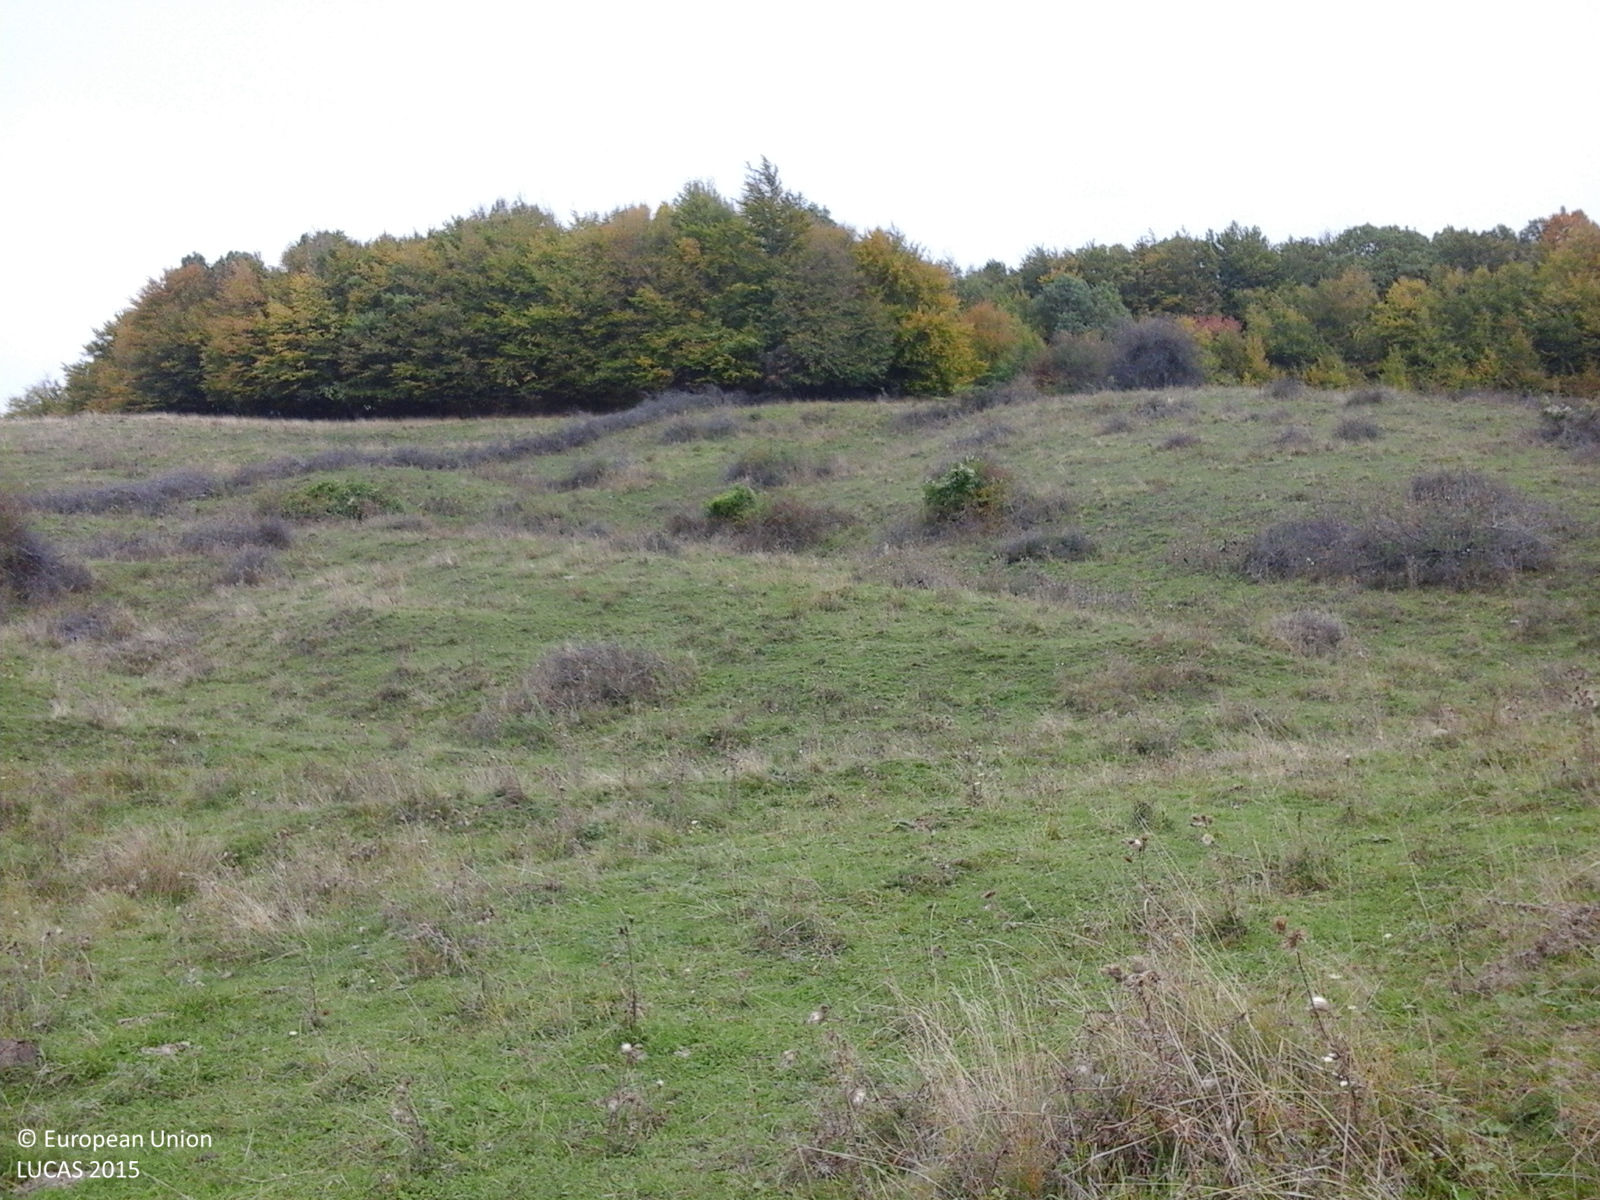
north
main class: Grassland
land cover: Grassland without tree/shrub cover
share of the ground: > 75 %
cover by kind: herbaceous plants 100 %
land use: Agriculture (excluding fallow land and kitchen gardens)
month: October
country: RO
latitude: 46.6157
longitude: 24.9172
